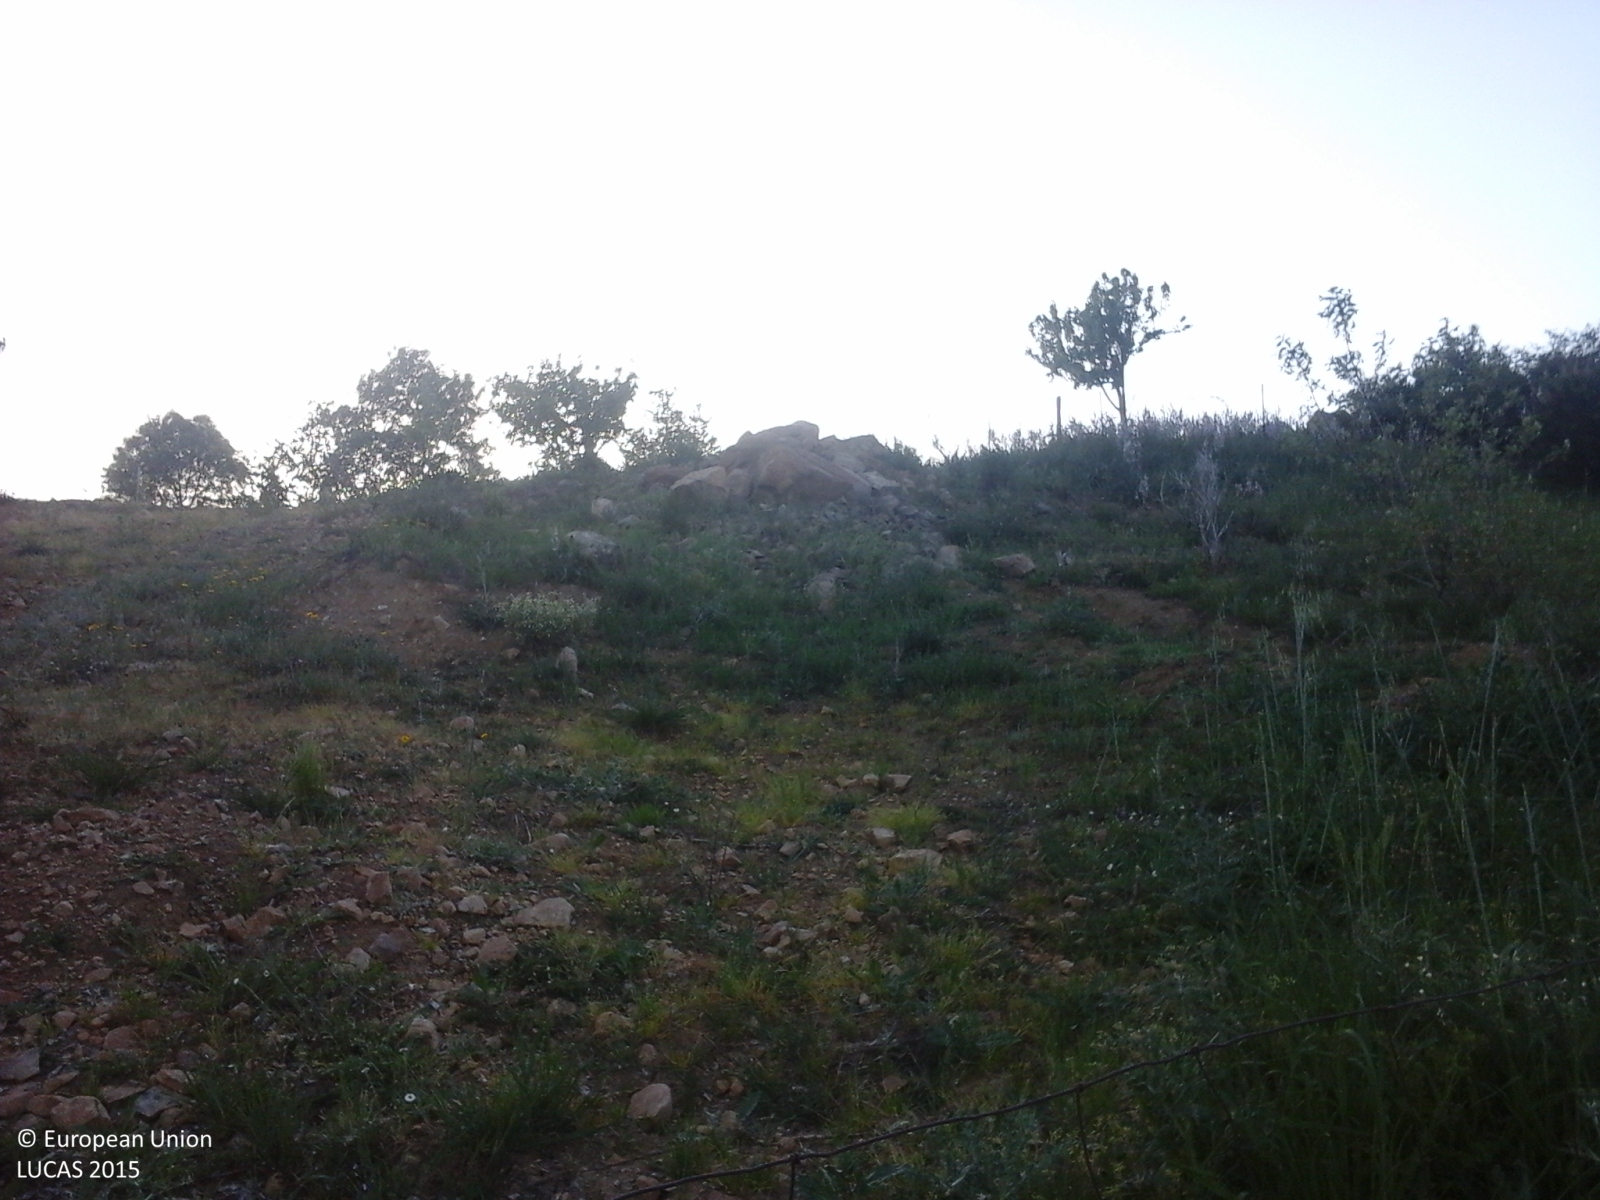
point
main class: Cropland
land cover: Pear fruit
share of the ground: 25 - 50 %
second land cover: Spontaneously vegetated surfaces
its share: > 75 %
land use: Agriculture (excluding fallow land and kitchen gardens)
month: May
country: IT
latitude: 37.8210
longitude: 14.1398
